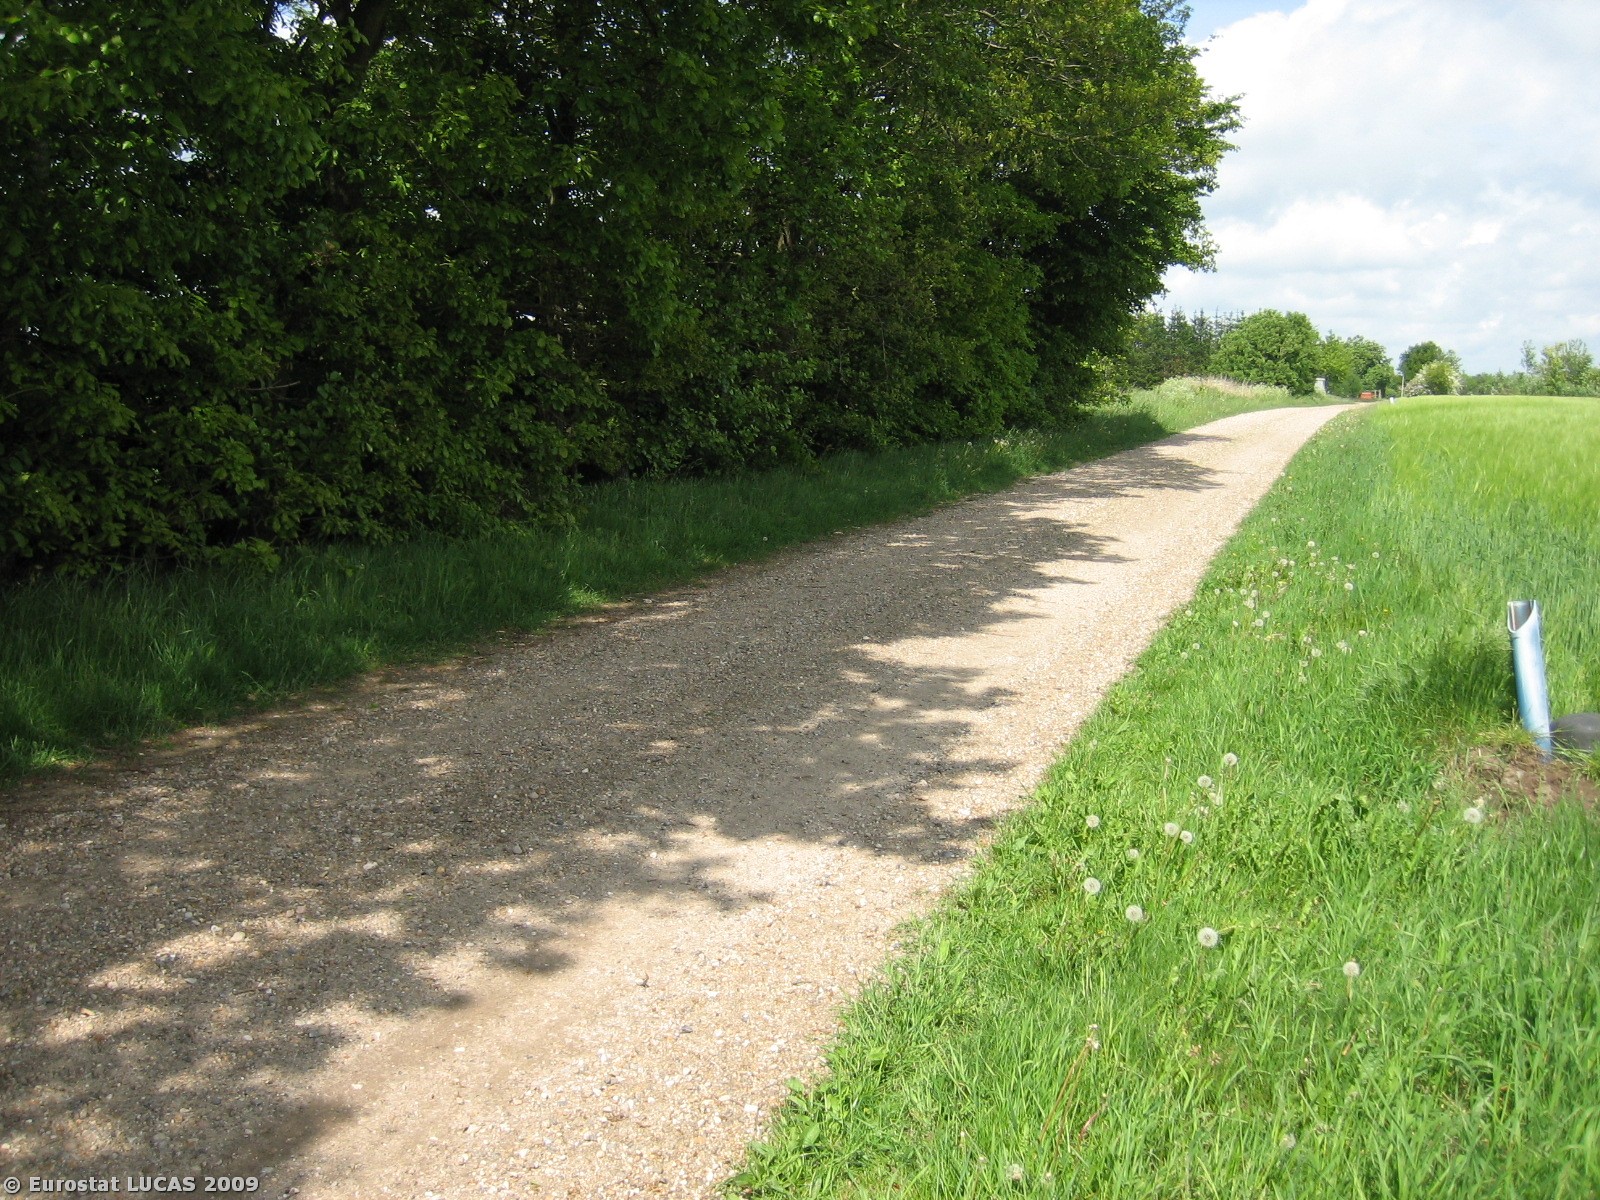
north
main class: Cropland
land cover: Barley
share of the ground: > 75 %
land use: Agriculture (excluding fallow land and kitchen gardens)
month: May
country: DK
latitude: 55.9661
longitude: 8.7677
